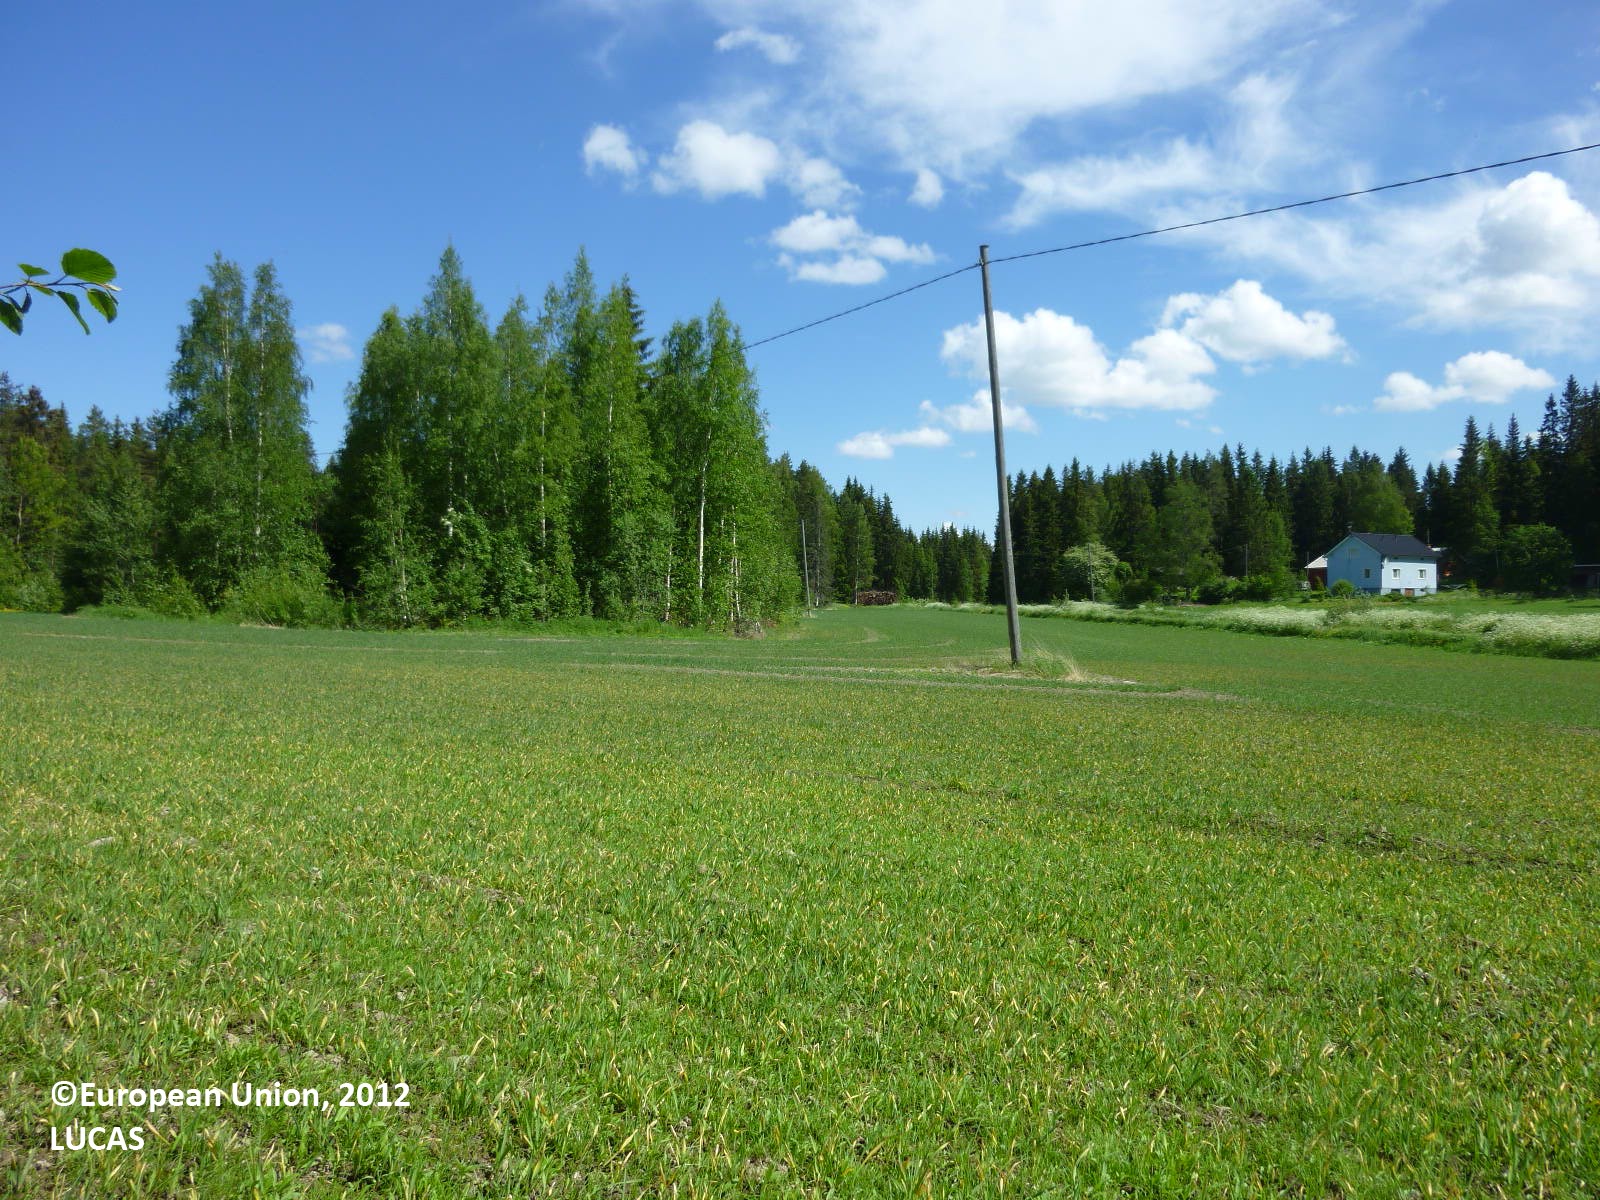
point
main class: Cropland
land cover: Barley
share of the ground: 25 - 50 %
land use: Agriculture (excluding fallow land and kitchen gardens)
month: June
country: FI
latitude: 61.4860
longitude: 22.7044
